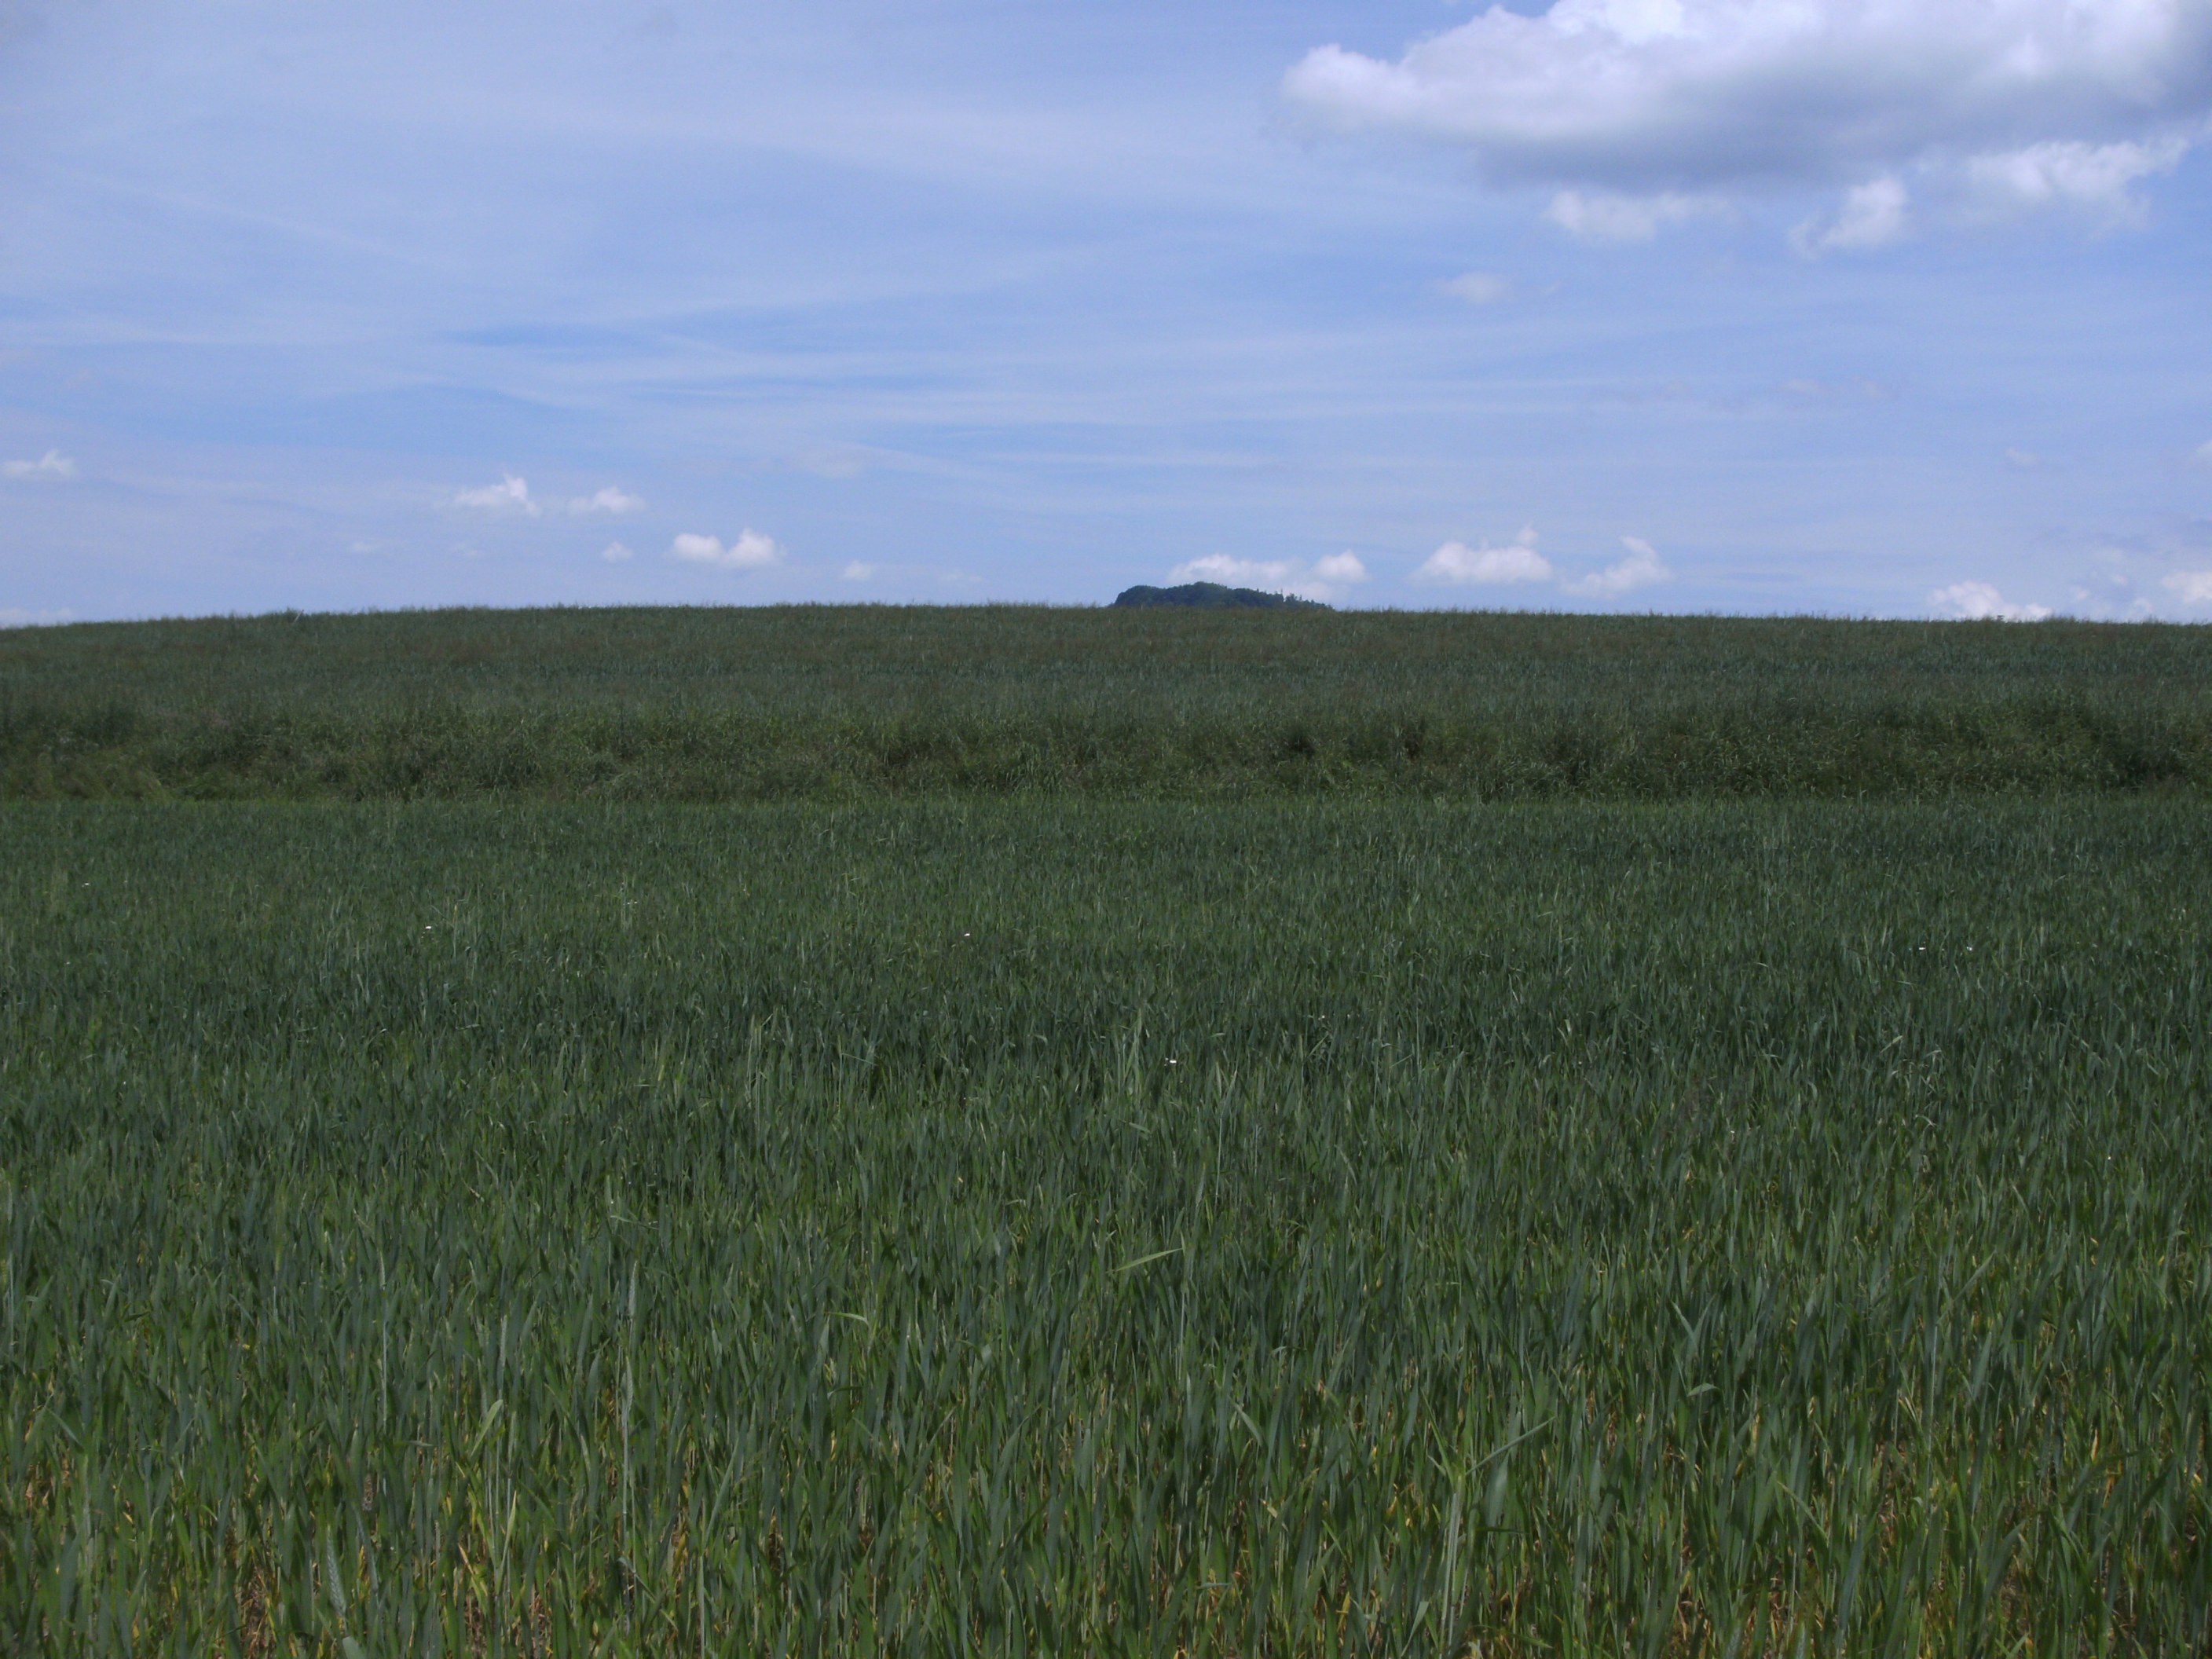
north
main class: Cropland
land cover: Triticale
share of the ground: > 75 %
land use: Agriculture (excluding fallow land and kitchen gardens)
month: June
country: AT
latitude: 48.0599
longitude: 13.5012
